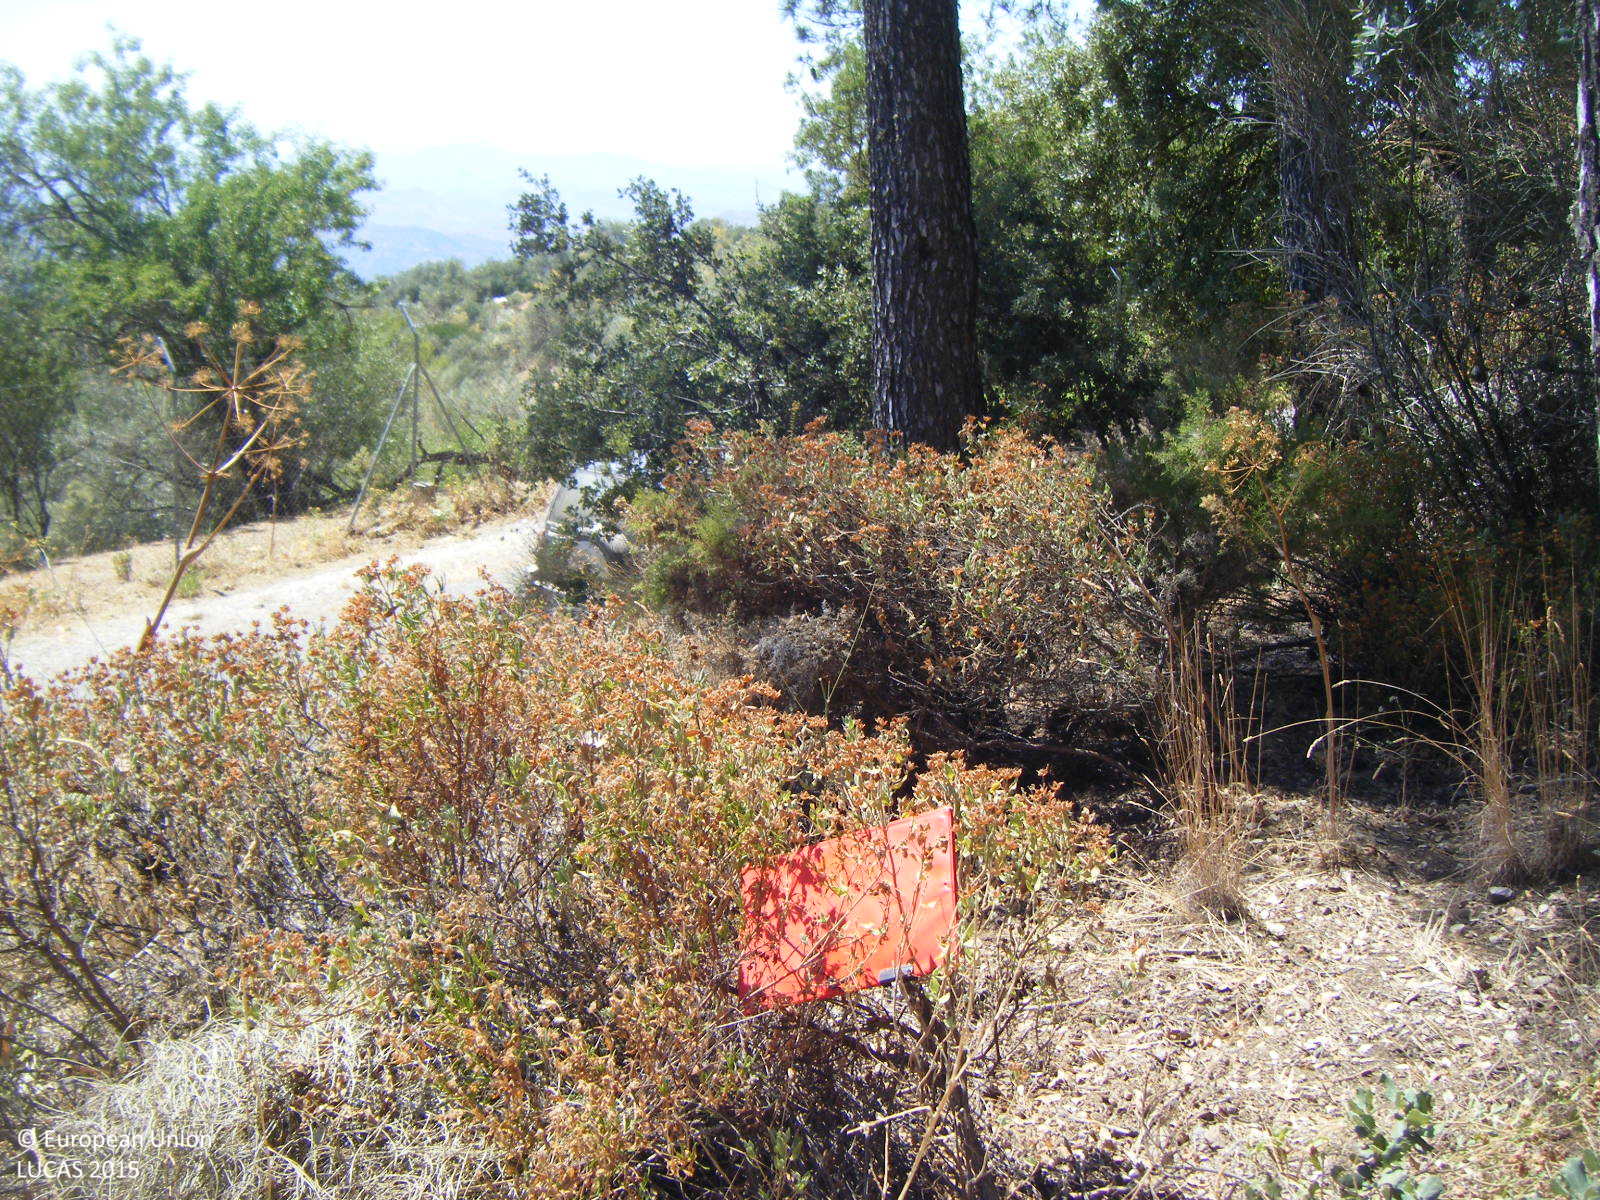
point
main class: Woodland
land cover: Pine dominated coniferous woodland
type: coniferous forest of the mediterranean region
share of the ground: 10 - 25 %
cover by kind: shrubs 80 %, coniferous forest trees 20 %
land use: Forestry
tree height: > 5 m
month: July
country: ES
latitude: 36.8150
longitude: -4.3733
